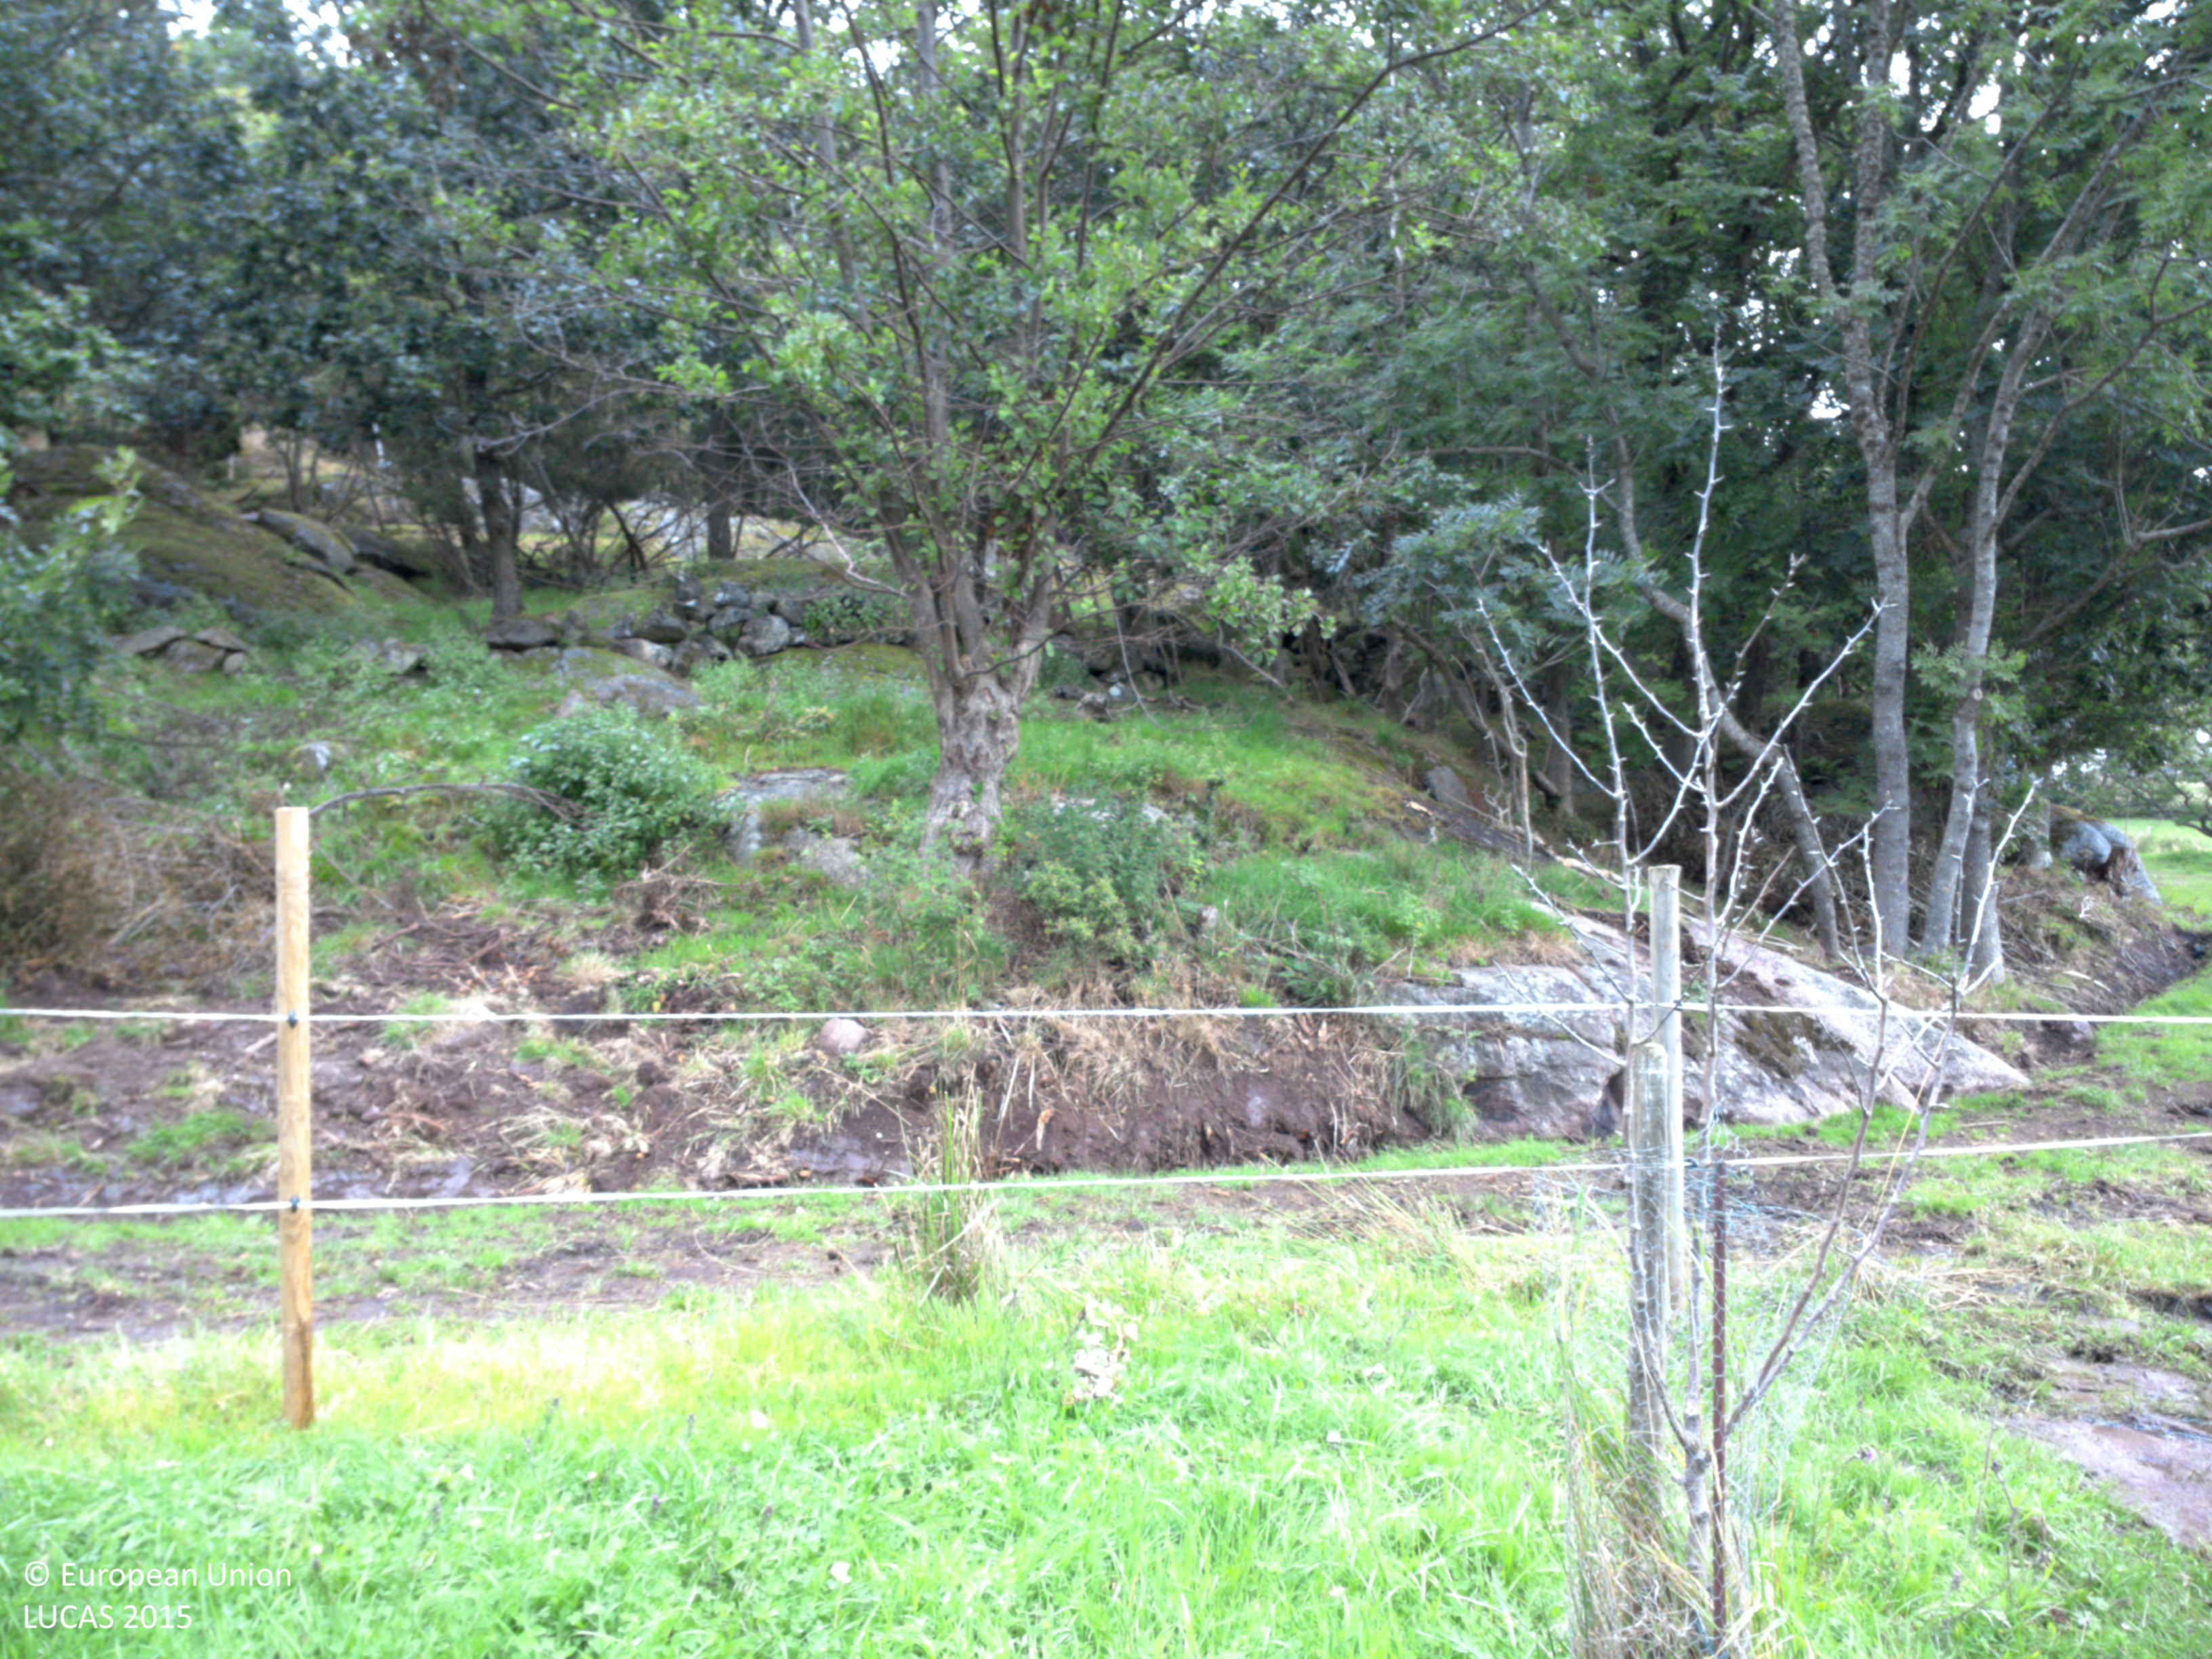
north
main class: Grassland
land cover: Grassland without tree/shrub cover
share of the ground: > 75 %
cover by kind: herbaceous plants 90 %, unconsolidated bare surface 10 %
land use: Residential
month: July
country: SE
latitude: 58.0484
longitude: 11.5726
